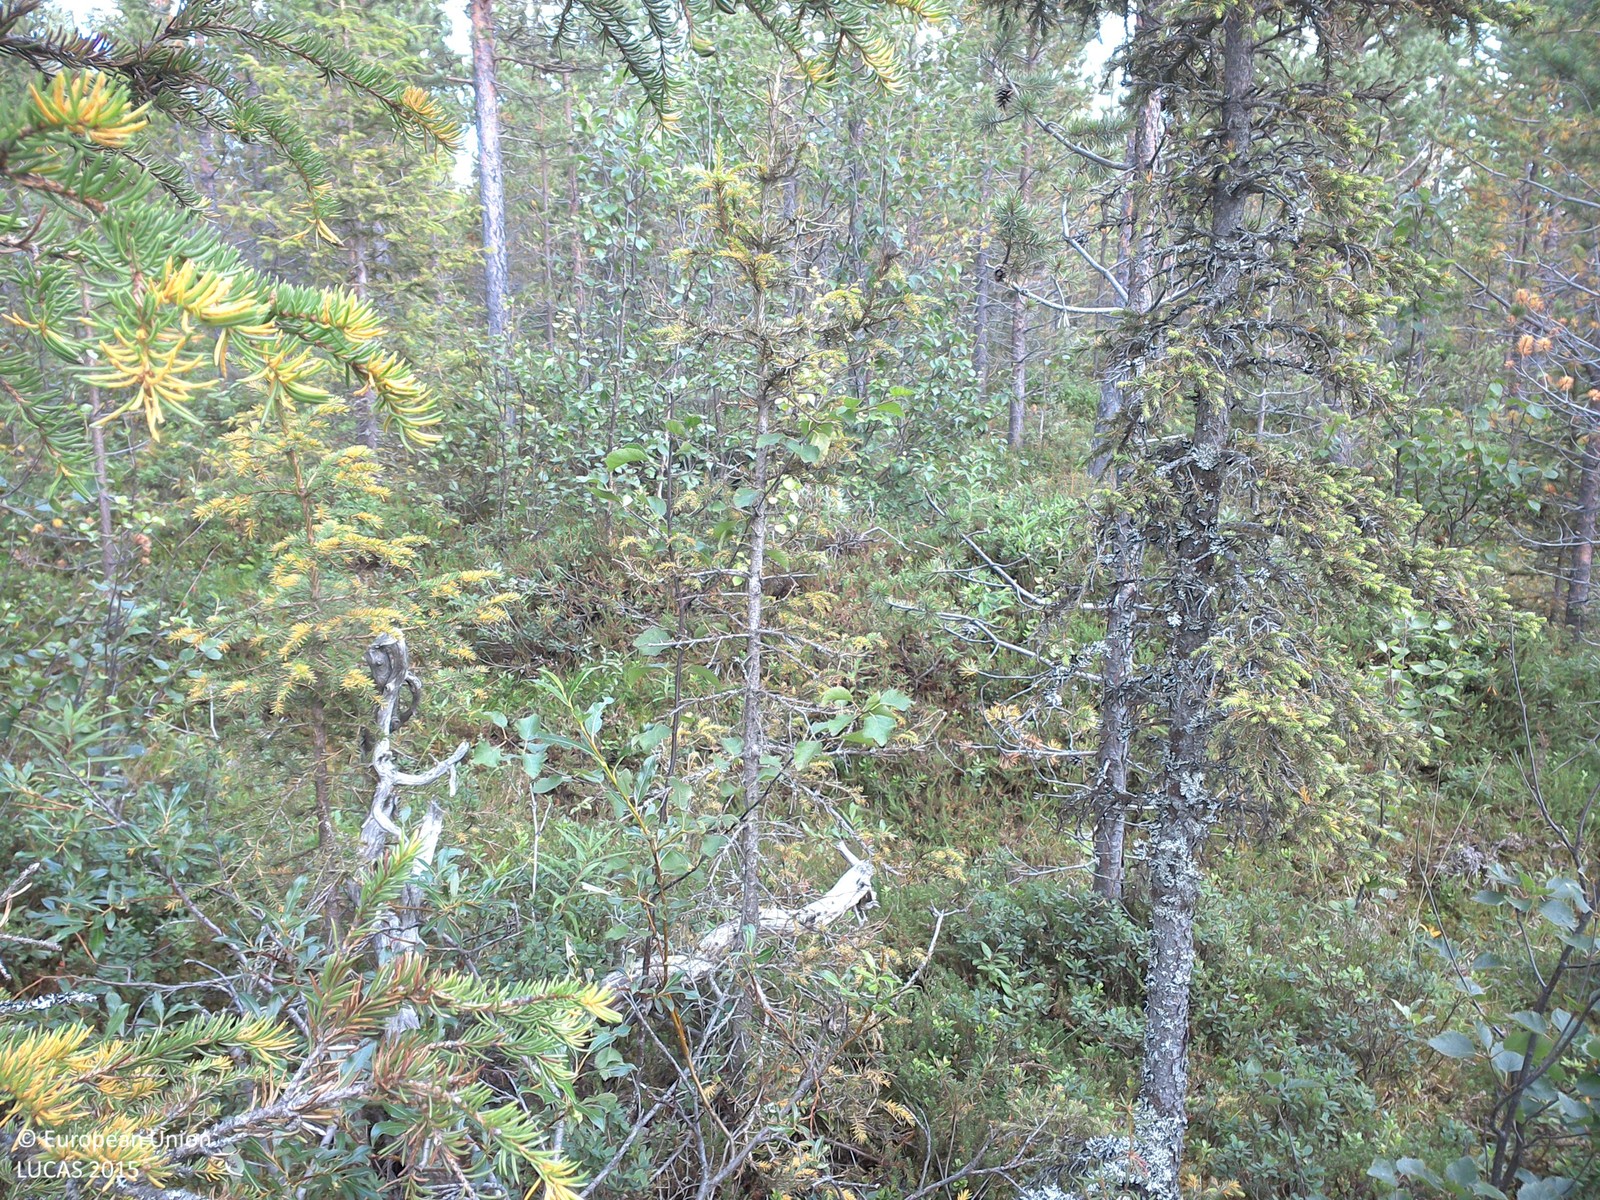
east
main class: Woodland
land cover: Pine dominated coniferous woodland
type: boreal forest
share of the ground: 25 - 50 %
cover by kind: shrubs 55 %, coniferous forest trees 30 %, lichens and mosses 10 %, broadleaved forest trees 5 %
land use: Forestry
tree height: < 5 m
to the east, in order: Pine dominated coniferous woodland; Ditches and canals; Pine dominated coniferous woodland; Shrubland without tree cover; Pine dominated coniferous woodland
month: August
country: SE
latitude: 67.8691
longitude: 20.5248
